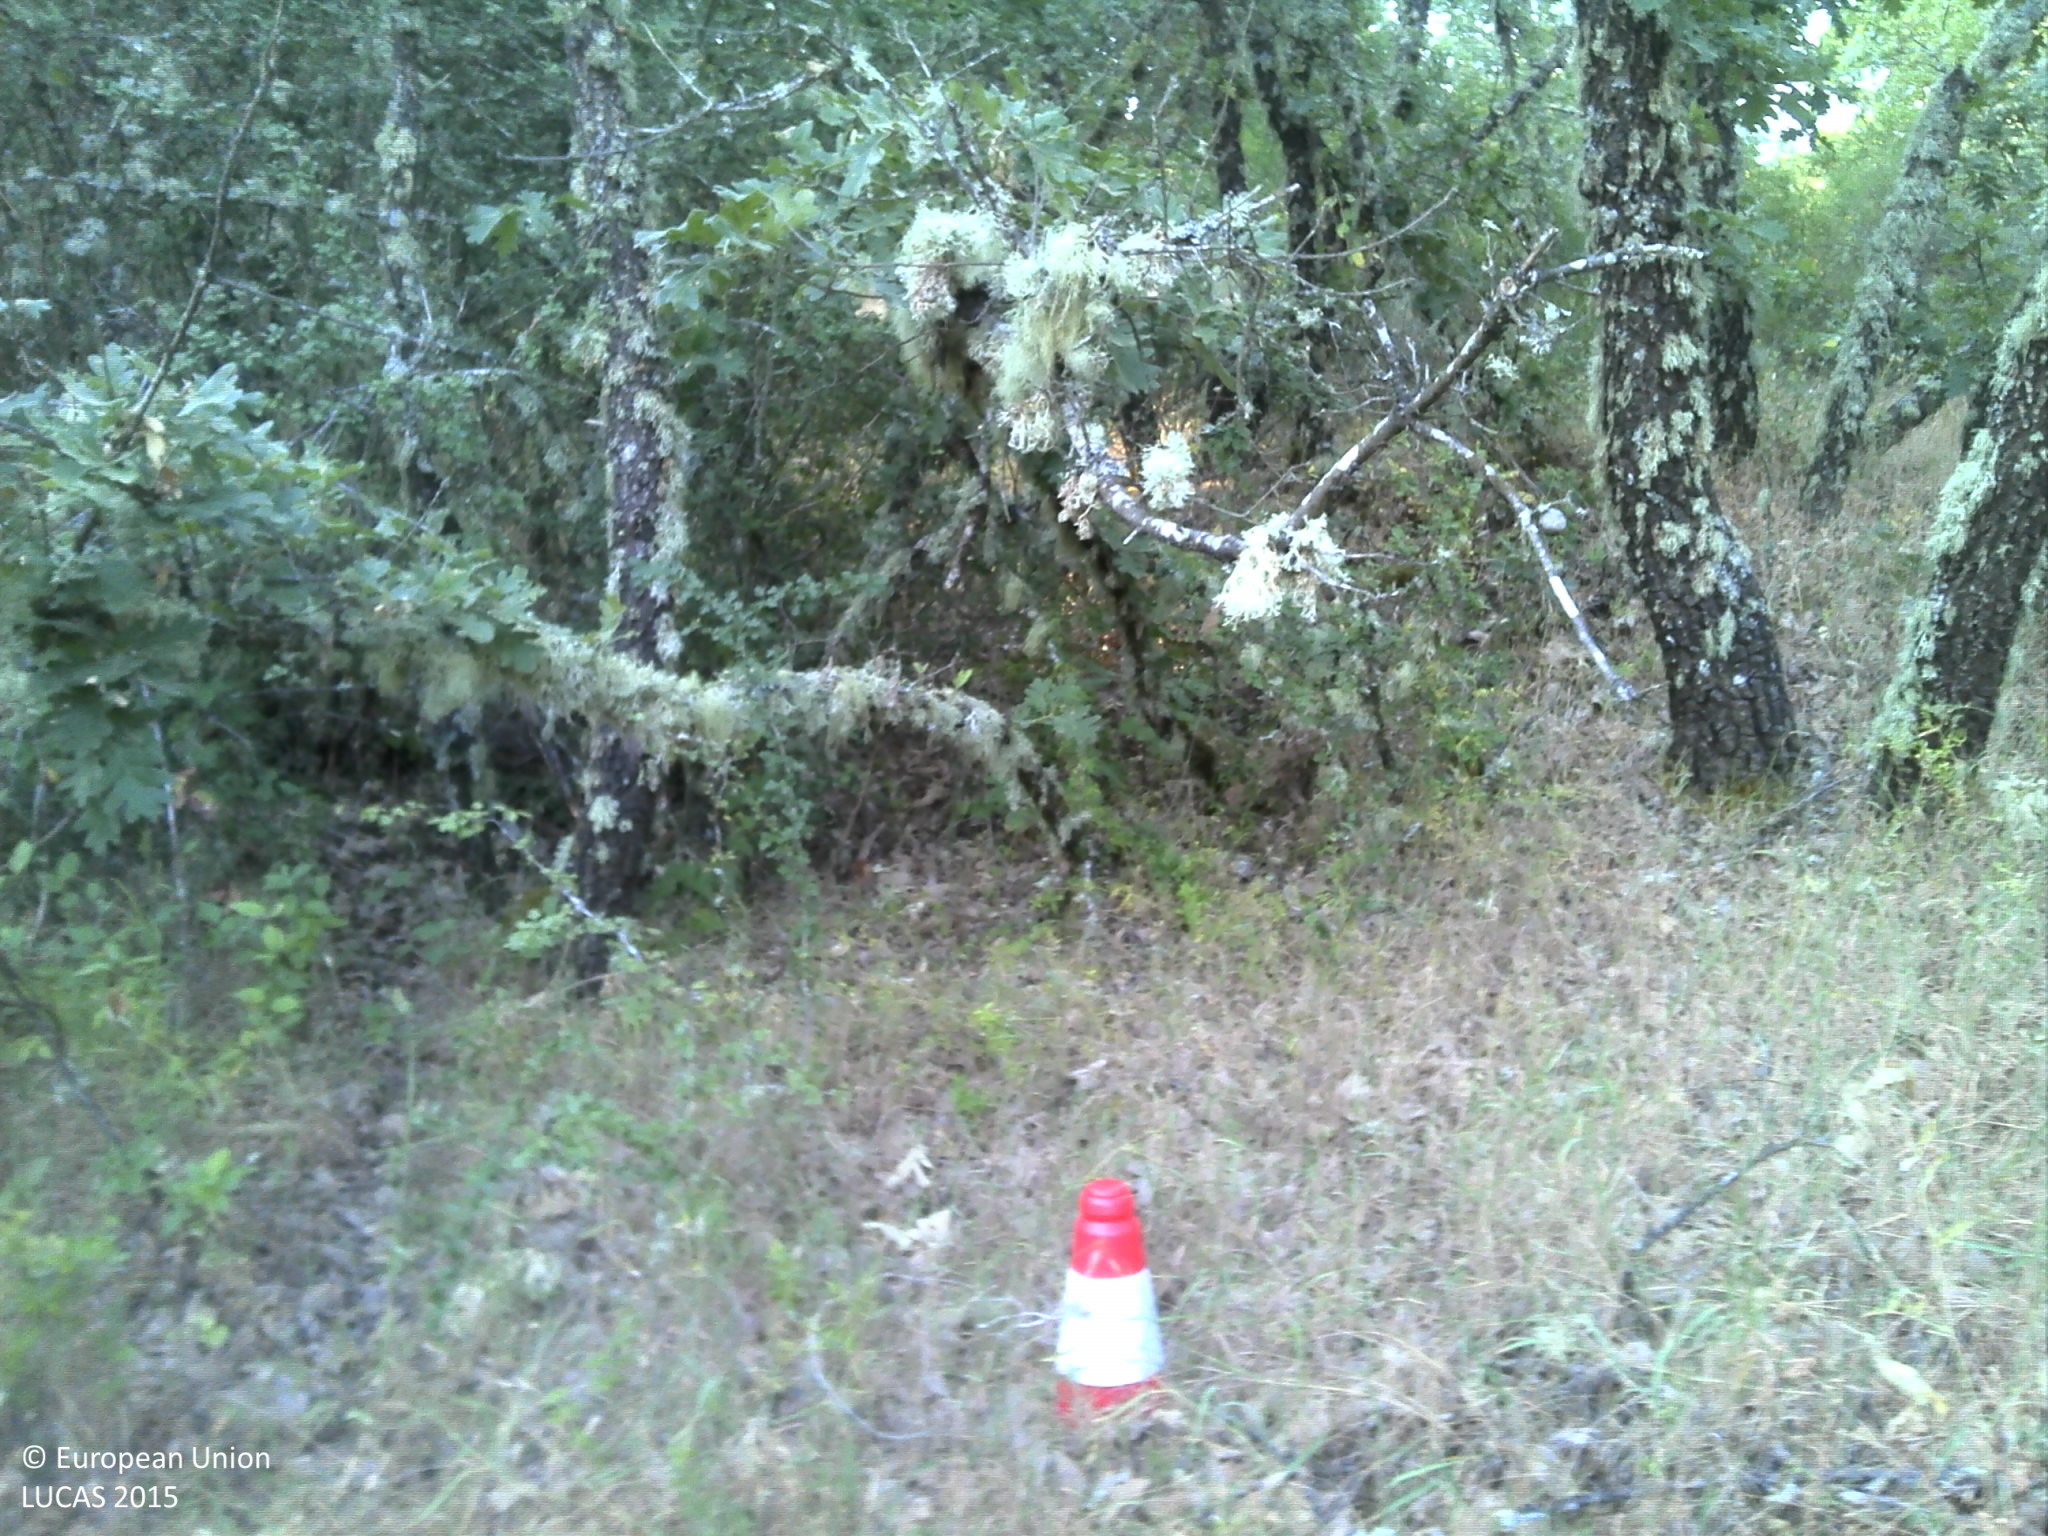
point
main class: Woodland
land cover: Broadleaved woodland
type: acidophilous oak and oak-birch forest
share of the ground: 50 - 75 %
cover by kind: broadleaved forest trees 65 %, shrubs 25 %, unconsolidated bare surface 5 %
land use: Forestry
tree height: > 5 m
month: June
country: PT
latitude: 40.2320
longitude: -7.3926
